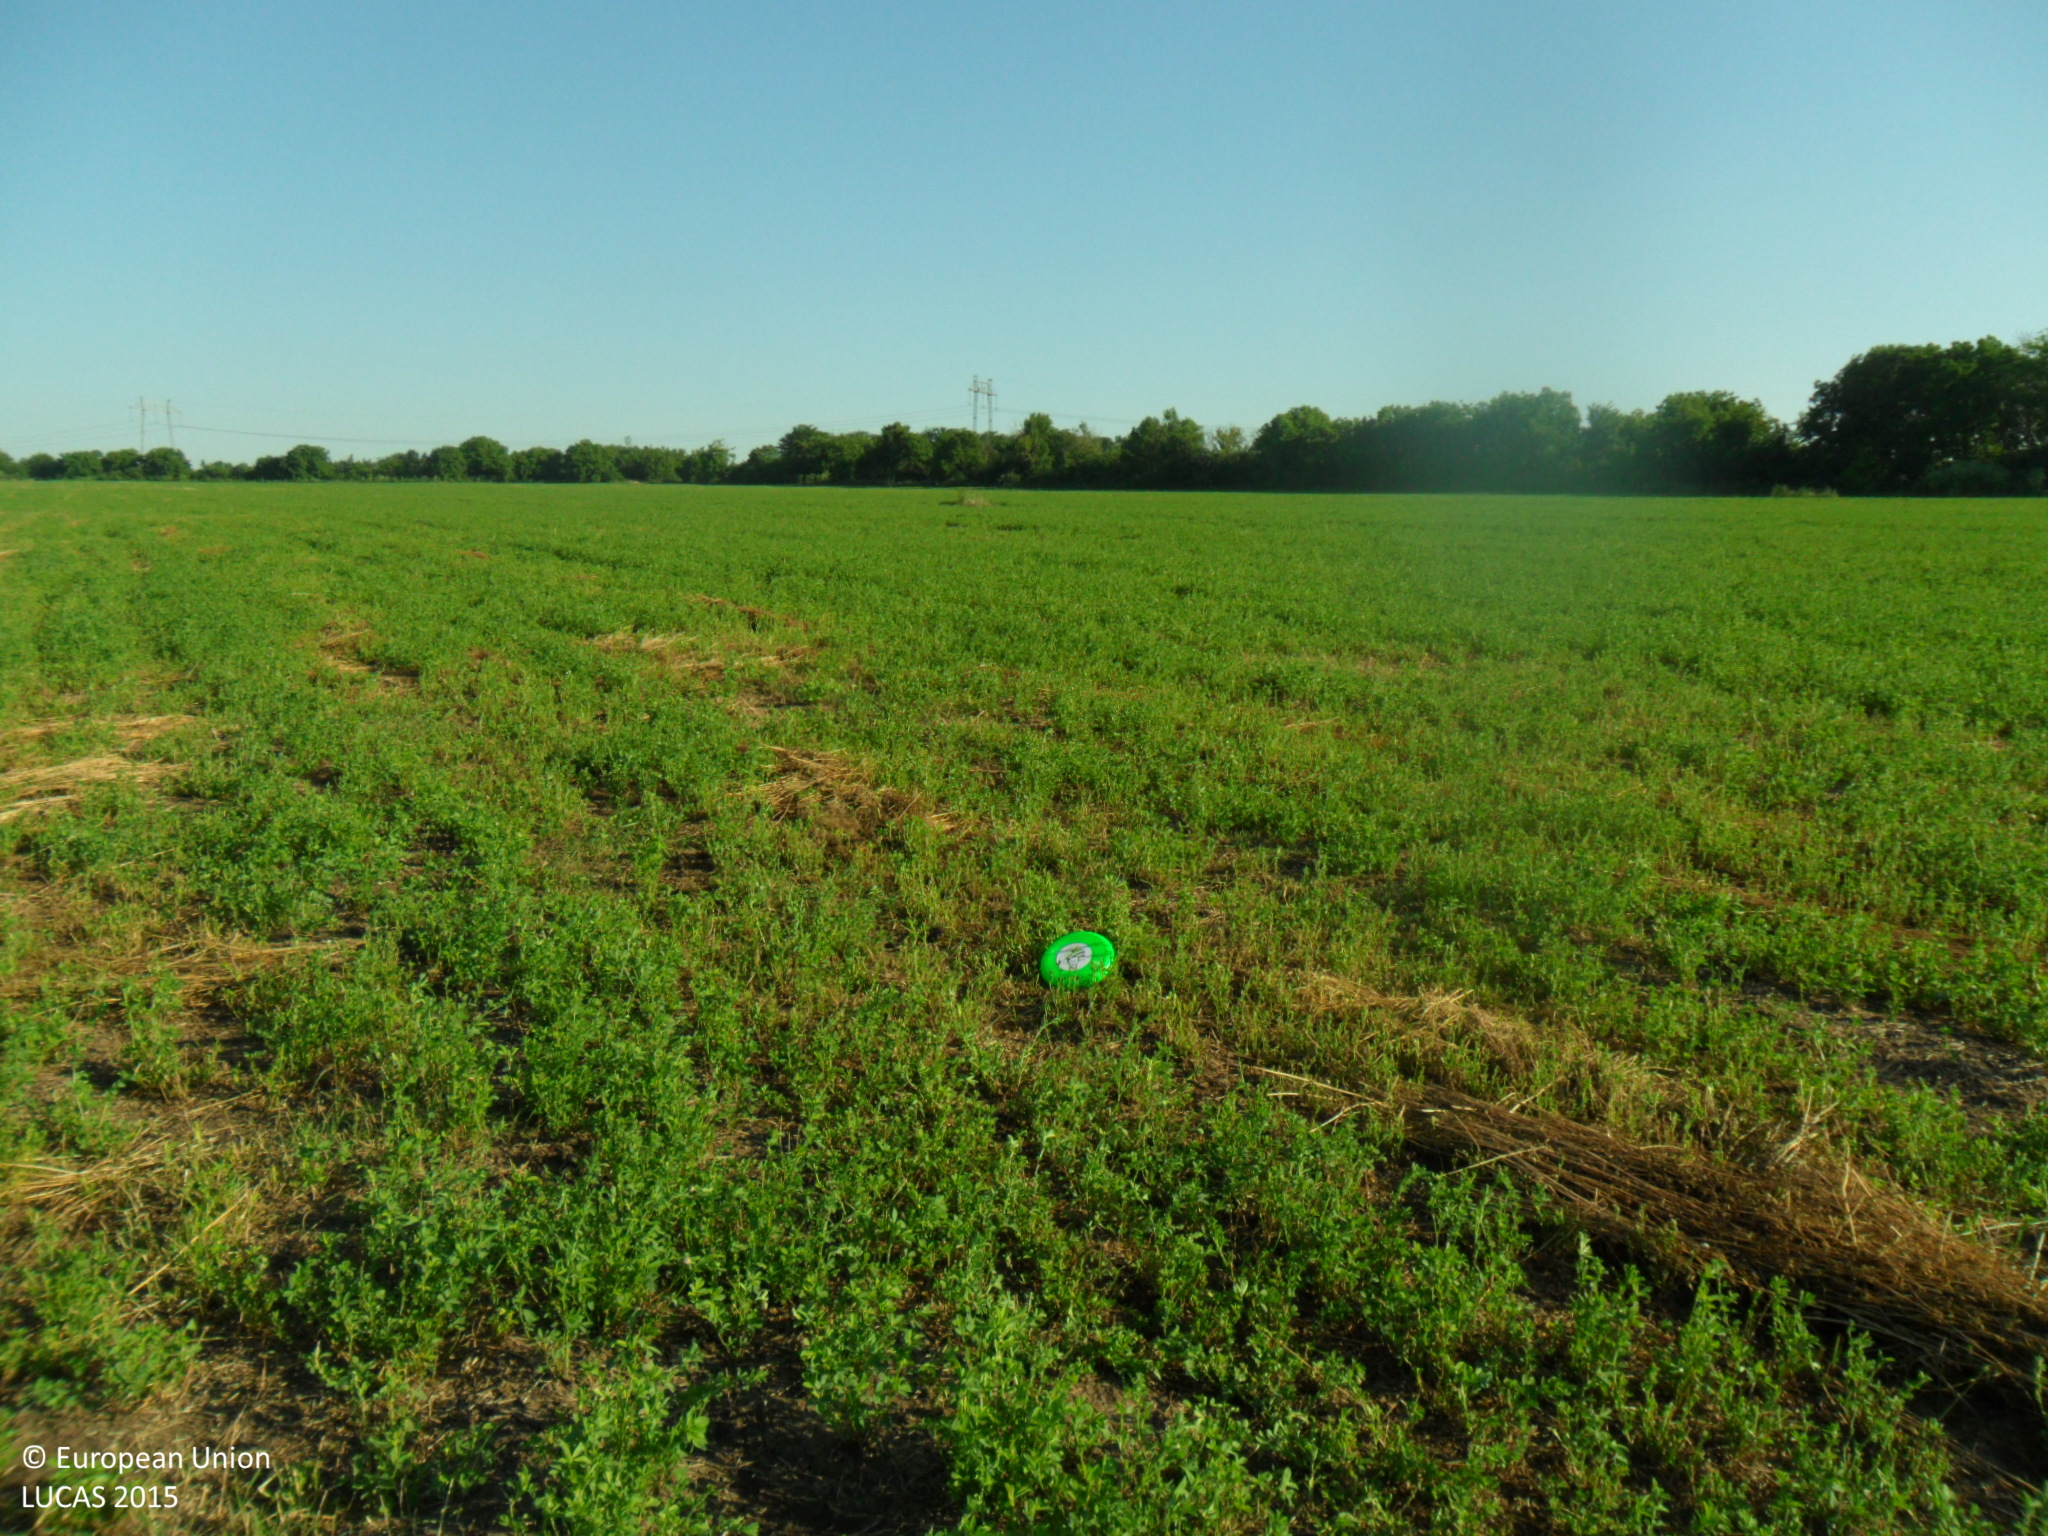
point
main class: Cropland
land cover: Lucerne
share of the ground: > 75 %
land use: Agriculture (excluding fallow land and kitchen gardens)
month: June
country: BG
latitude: 43.3141
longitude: 27.0450
